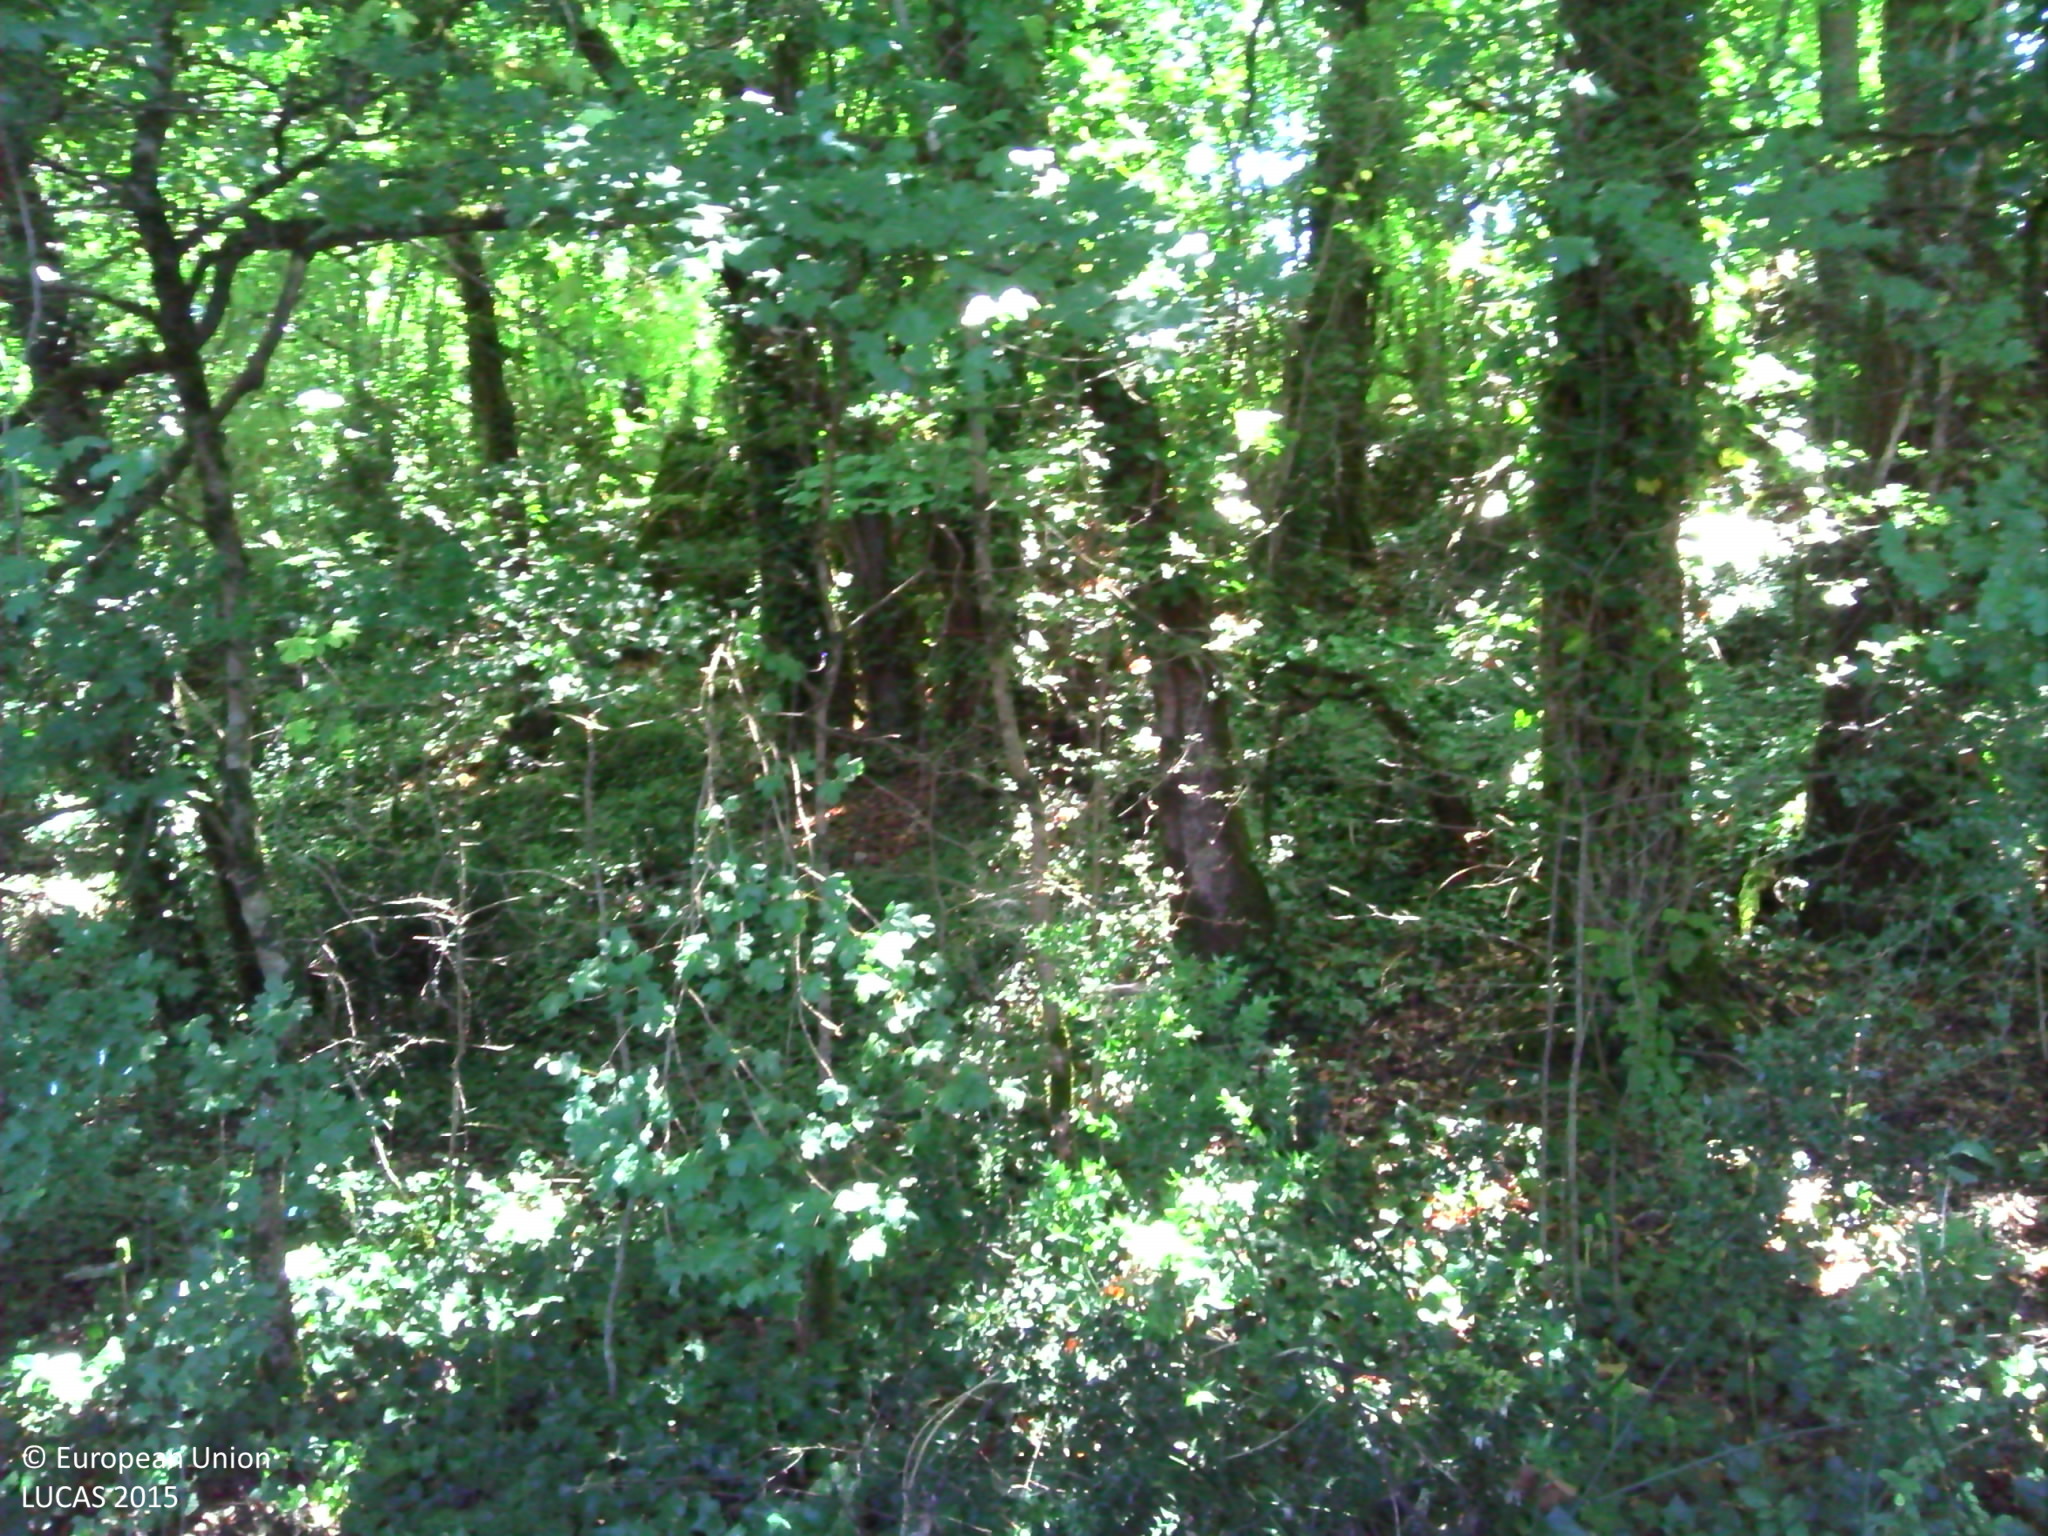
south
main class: Woodland
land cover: Broadleaved woodland
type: boreal forest
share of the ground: > 75 %
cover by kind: broadleaved forest trees 90 %, herbaceous plants 10 %
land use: Semi-natural and natural areas not in use
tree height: > 5 m
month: June
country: FR
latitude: 45.6132
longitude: 0.4326
